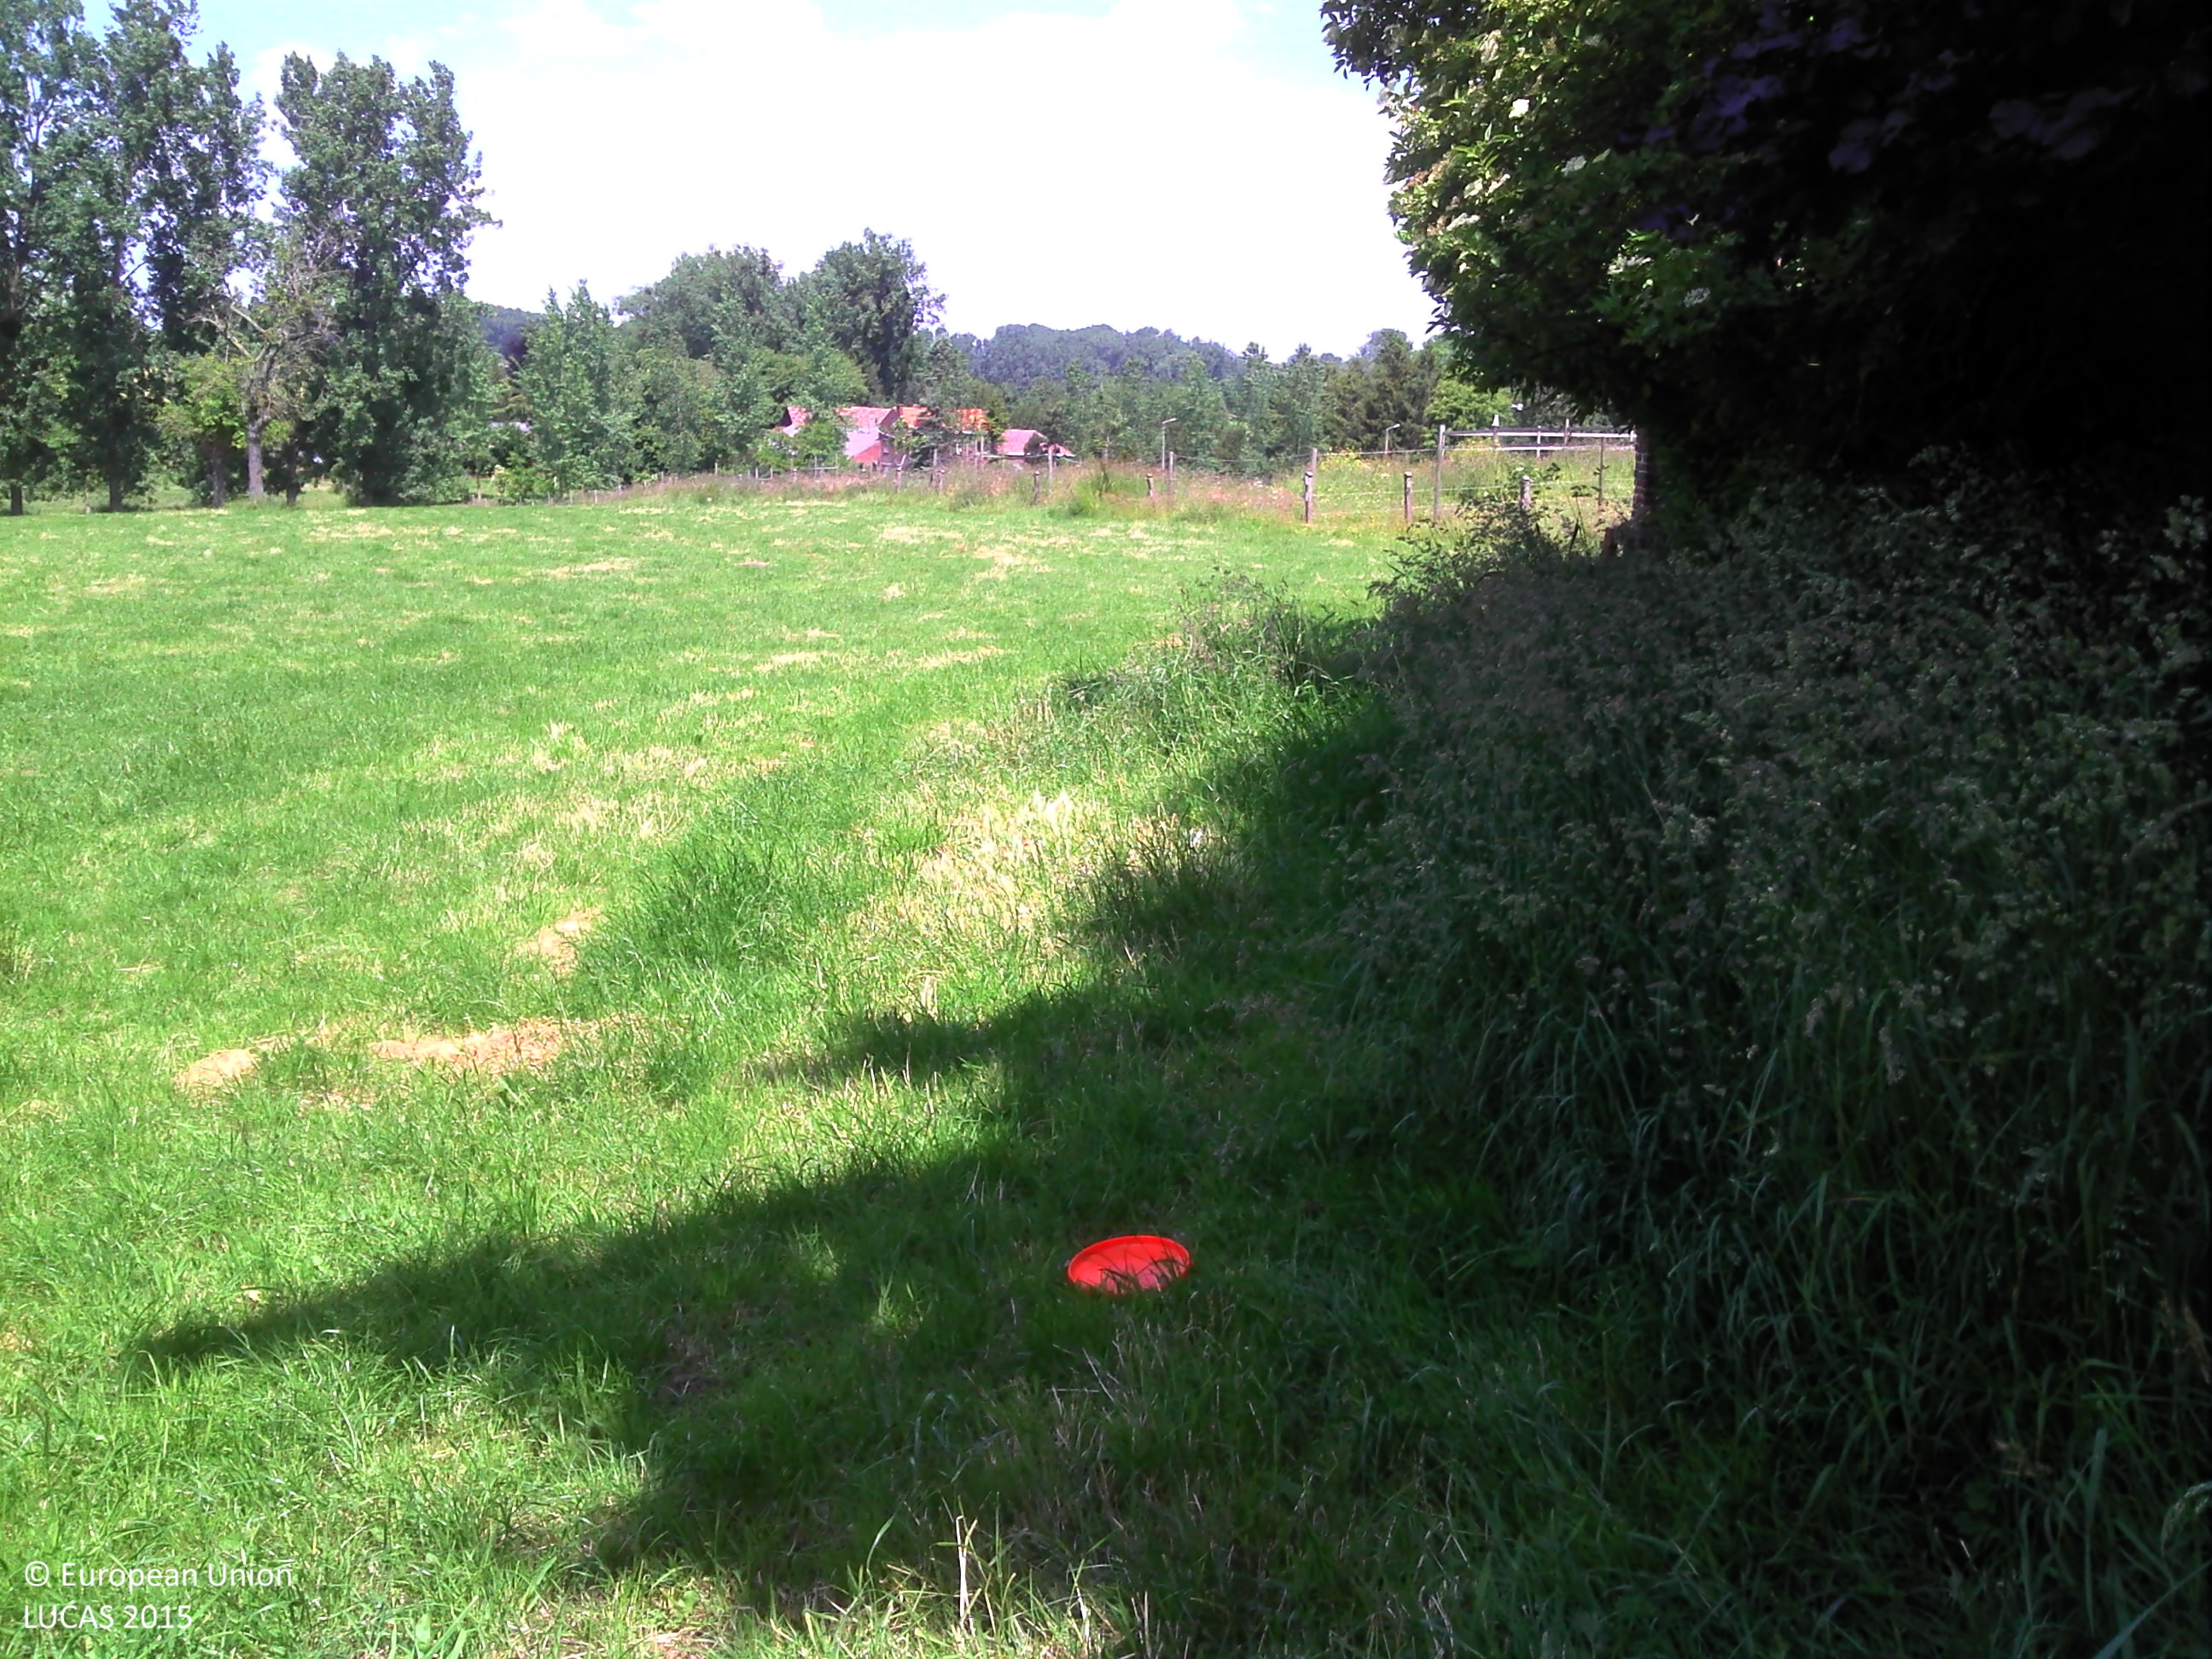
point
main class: Grassland
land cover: Grassland without tree/shrub cover
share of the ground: > 75 %
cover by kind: herbaceous plants 100 %
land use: Agriculture (excluding fallow land and kitchen gardens)
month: June
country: BE
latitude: 50.8135
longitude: 5.4422
